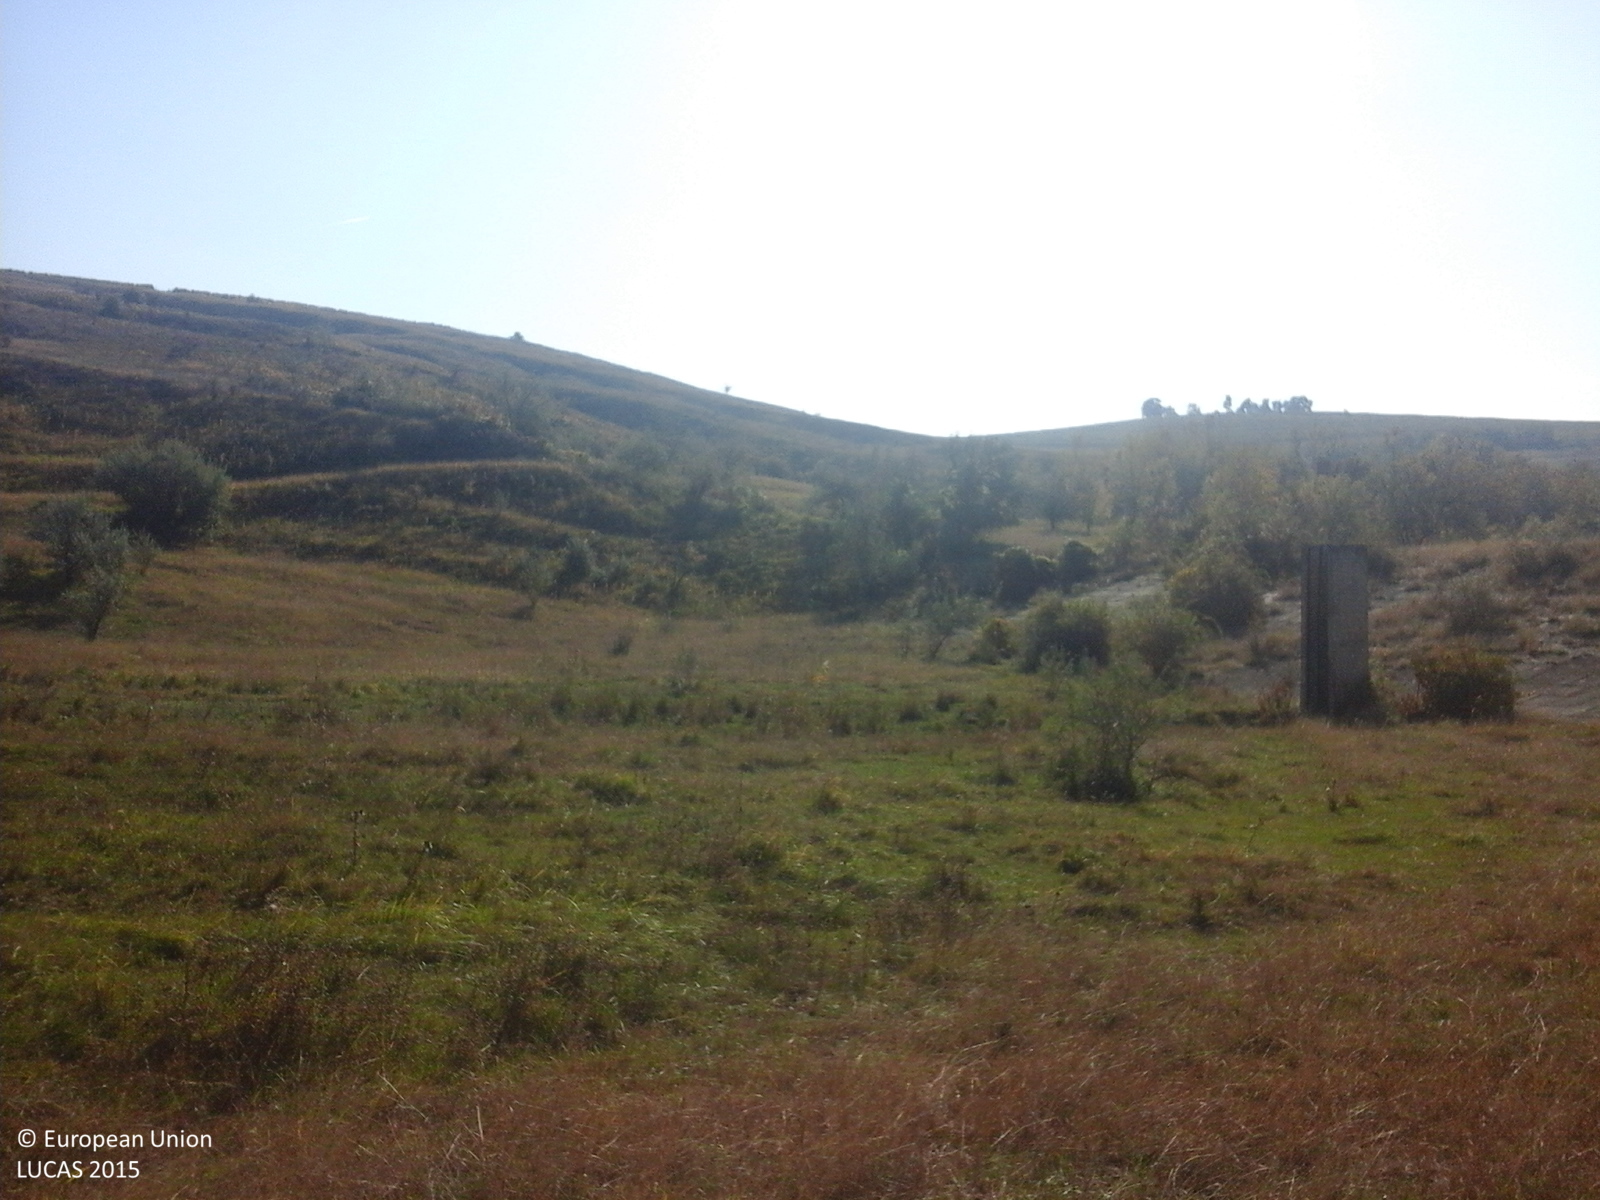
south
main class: Grassland
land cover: Grassland with sparse tree/shrub cover
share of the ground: > 75 %
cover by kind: herbaceous plants 85 %, shrubs 10 %, broadleaved forest trees 5 %
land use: Fallow land
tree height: < 5 m
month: October
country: RO
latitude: 45.0719
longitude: 26.4156
